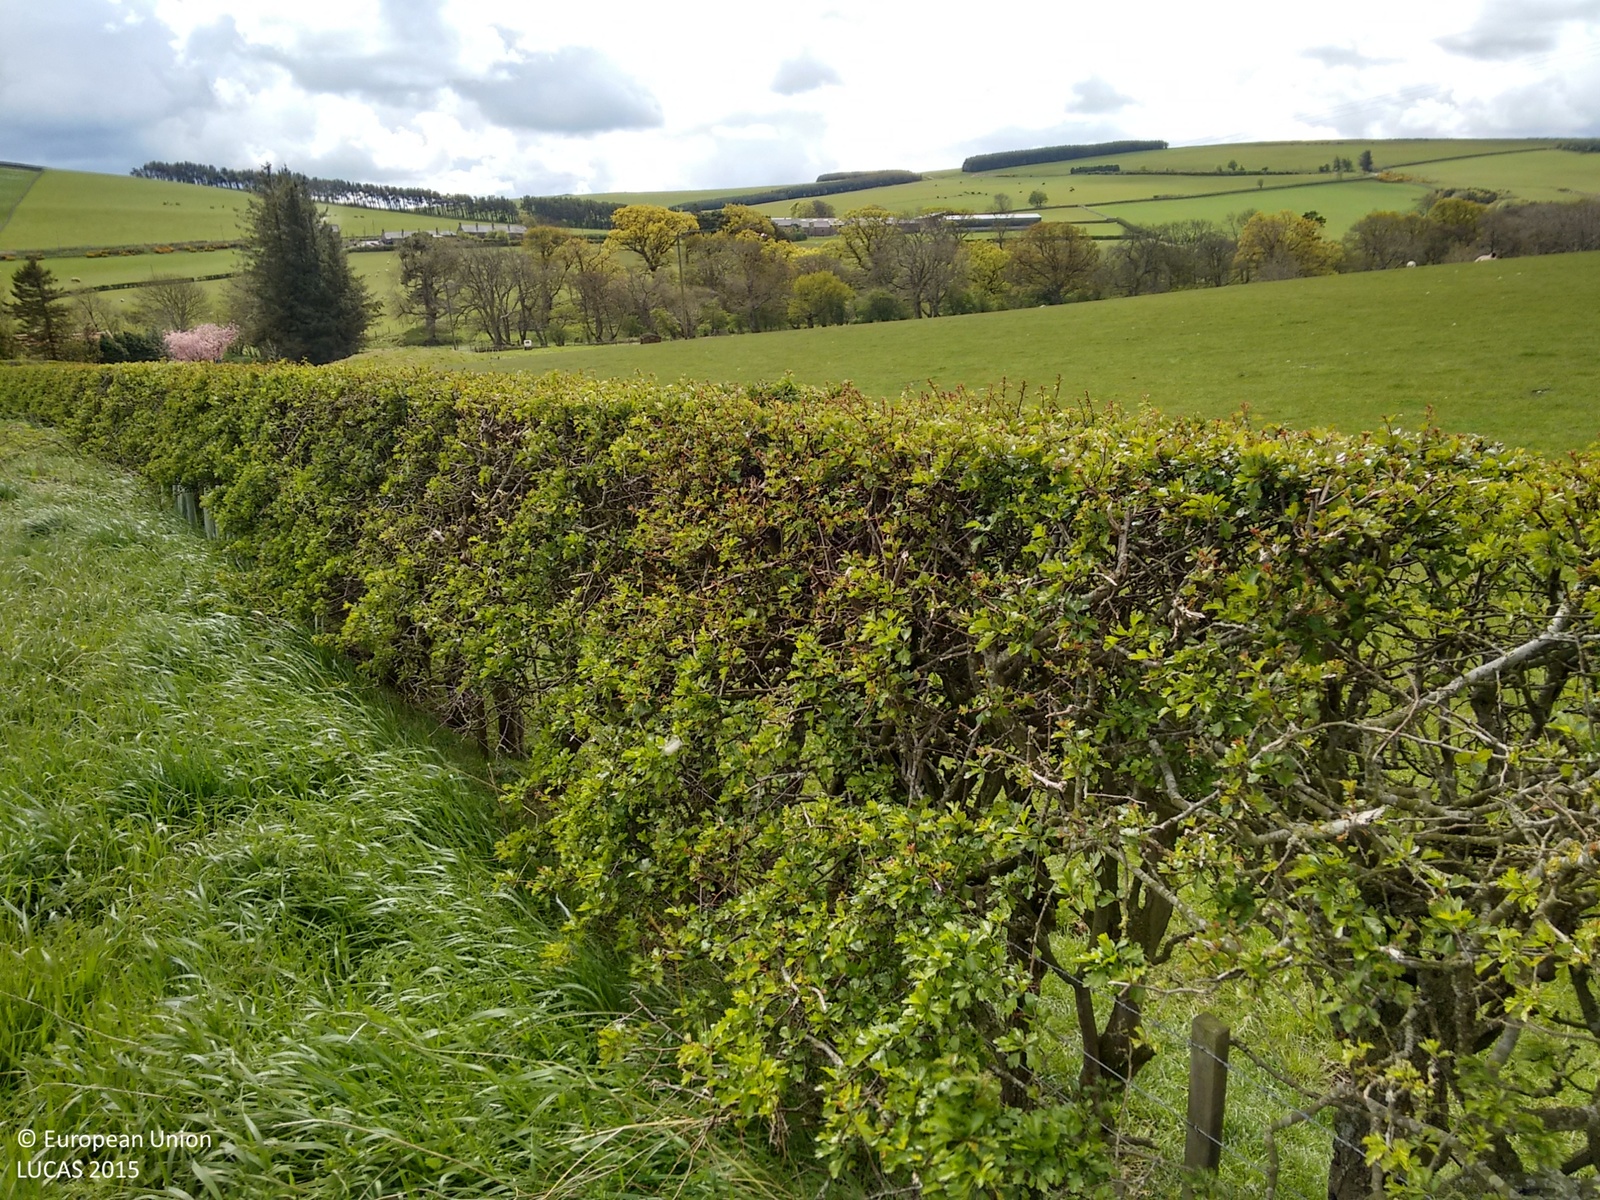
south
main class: Grassland
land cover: Grassland without tree/shrub cover
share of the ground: > 75 %
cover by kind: herbaceous plants 100 %
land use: Agriculture (excluding fallow land and kitchen gardens)
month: May
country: GB
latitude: 55.9120
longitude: -2.3925
